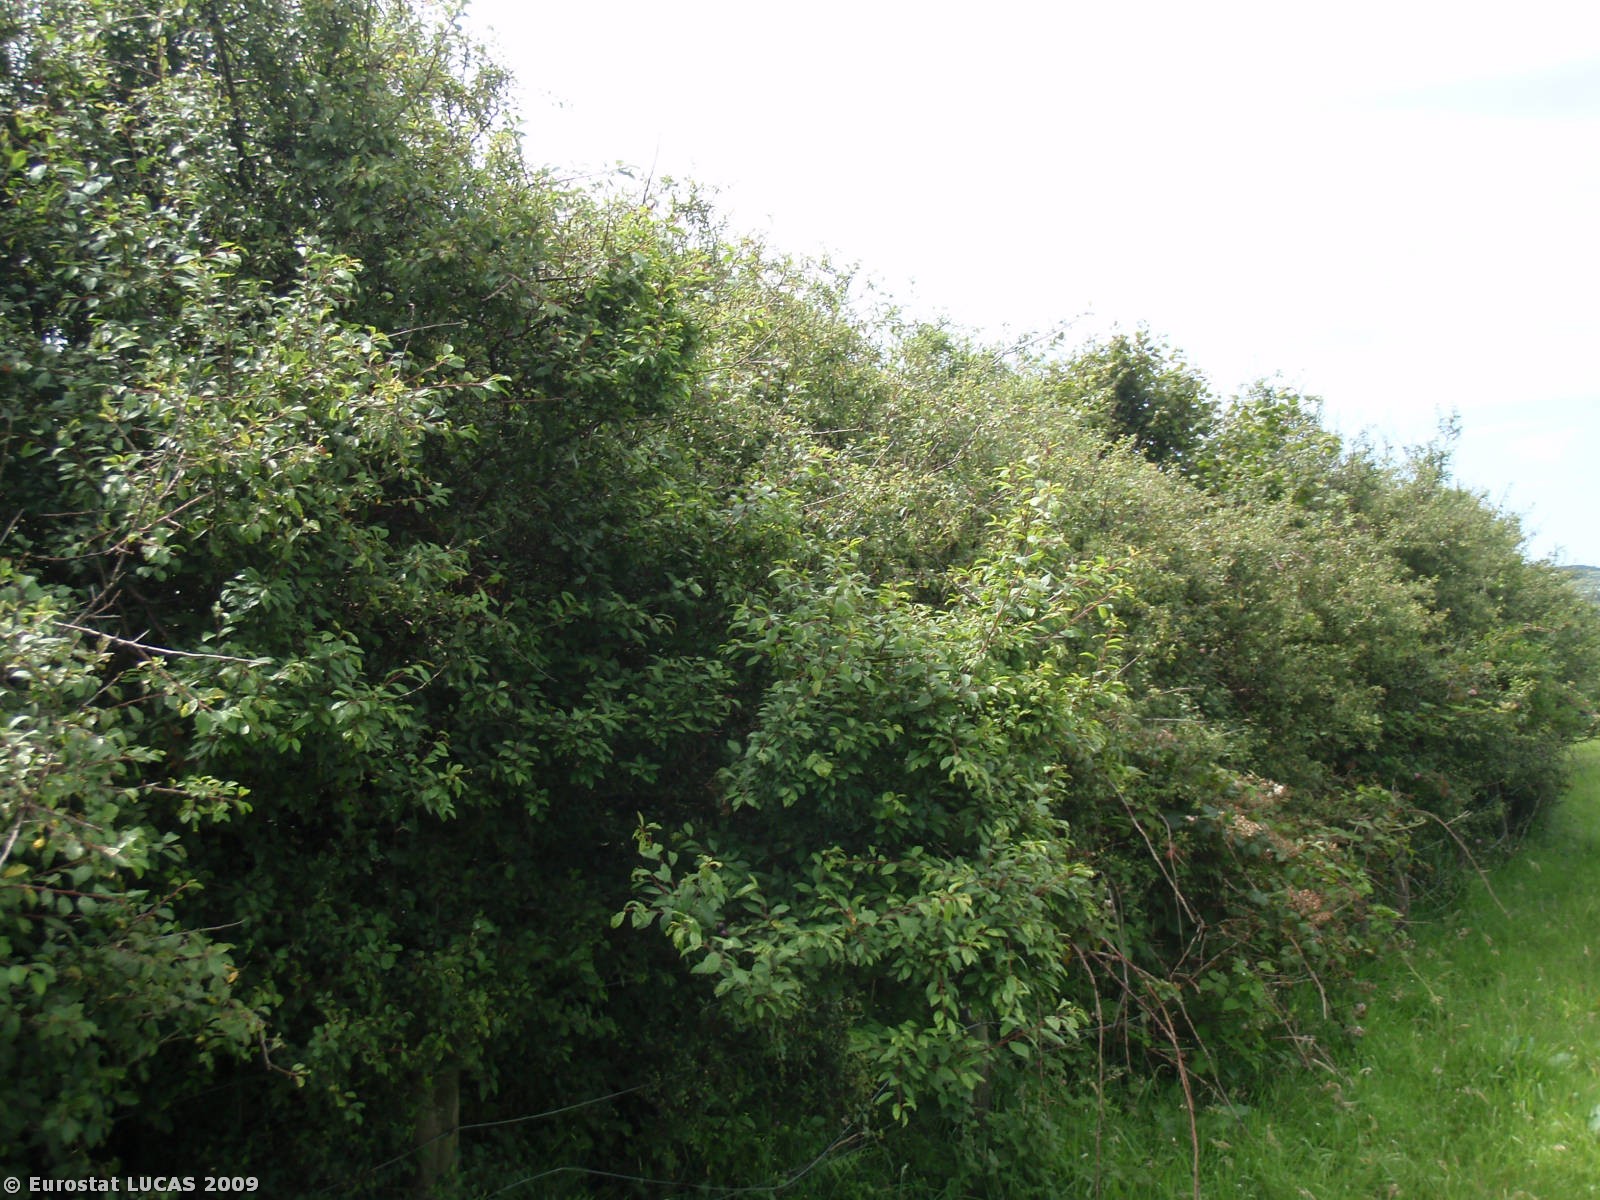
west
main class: Grassland
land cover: Grassland without tree/shrub cover
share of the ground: > 75 %
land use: Agriculture (excluding fallow land and kitchen gardens)
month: August
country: GB
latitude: 50.6379
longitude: -4.6579
